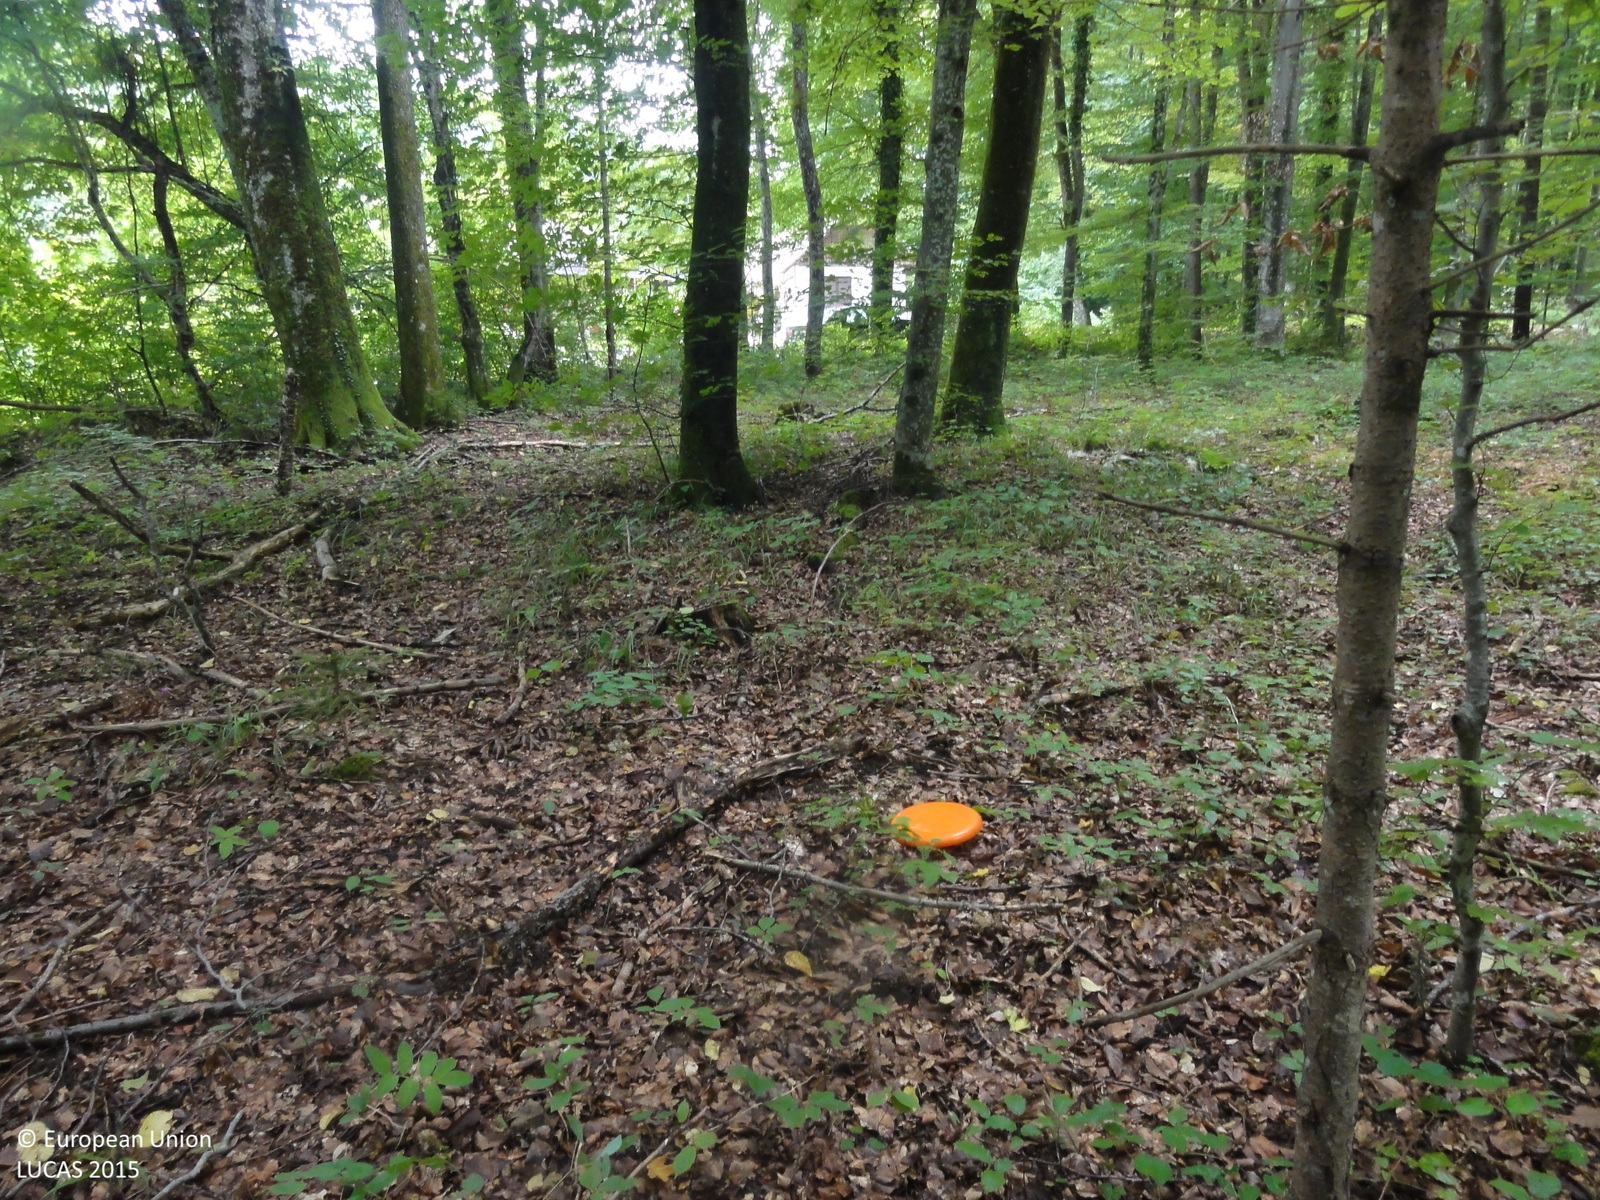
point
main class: Woodland
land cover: Broadleaved woodland
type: beech forest
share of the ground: > 75 %
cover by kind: broadleaved forest trees 95 %, coniferous forest trees 5 %
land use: Forestry
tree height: > 5 m
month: August
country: SI
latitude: 45.7423
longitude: 15.0989
